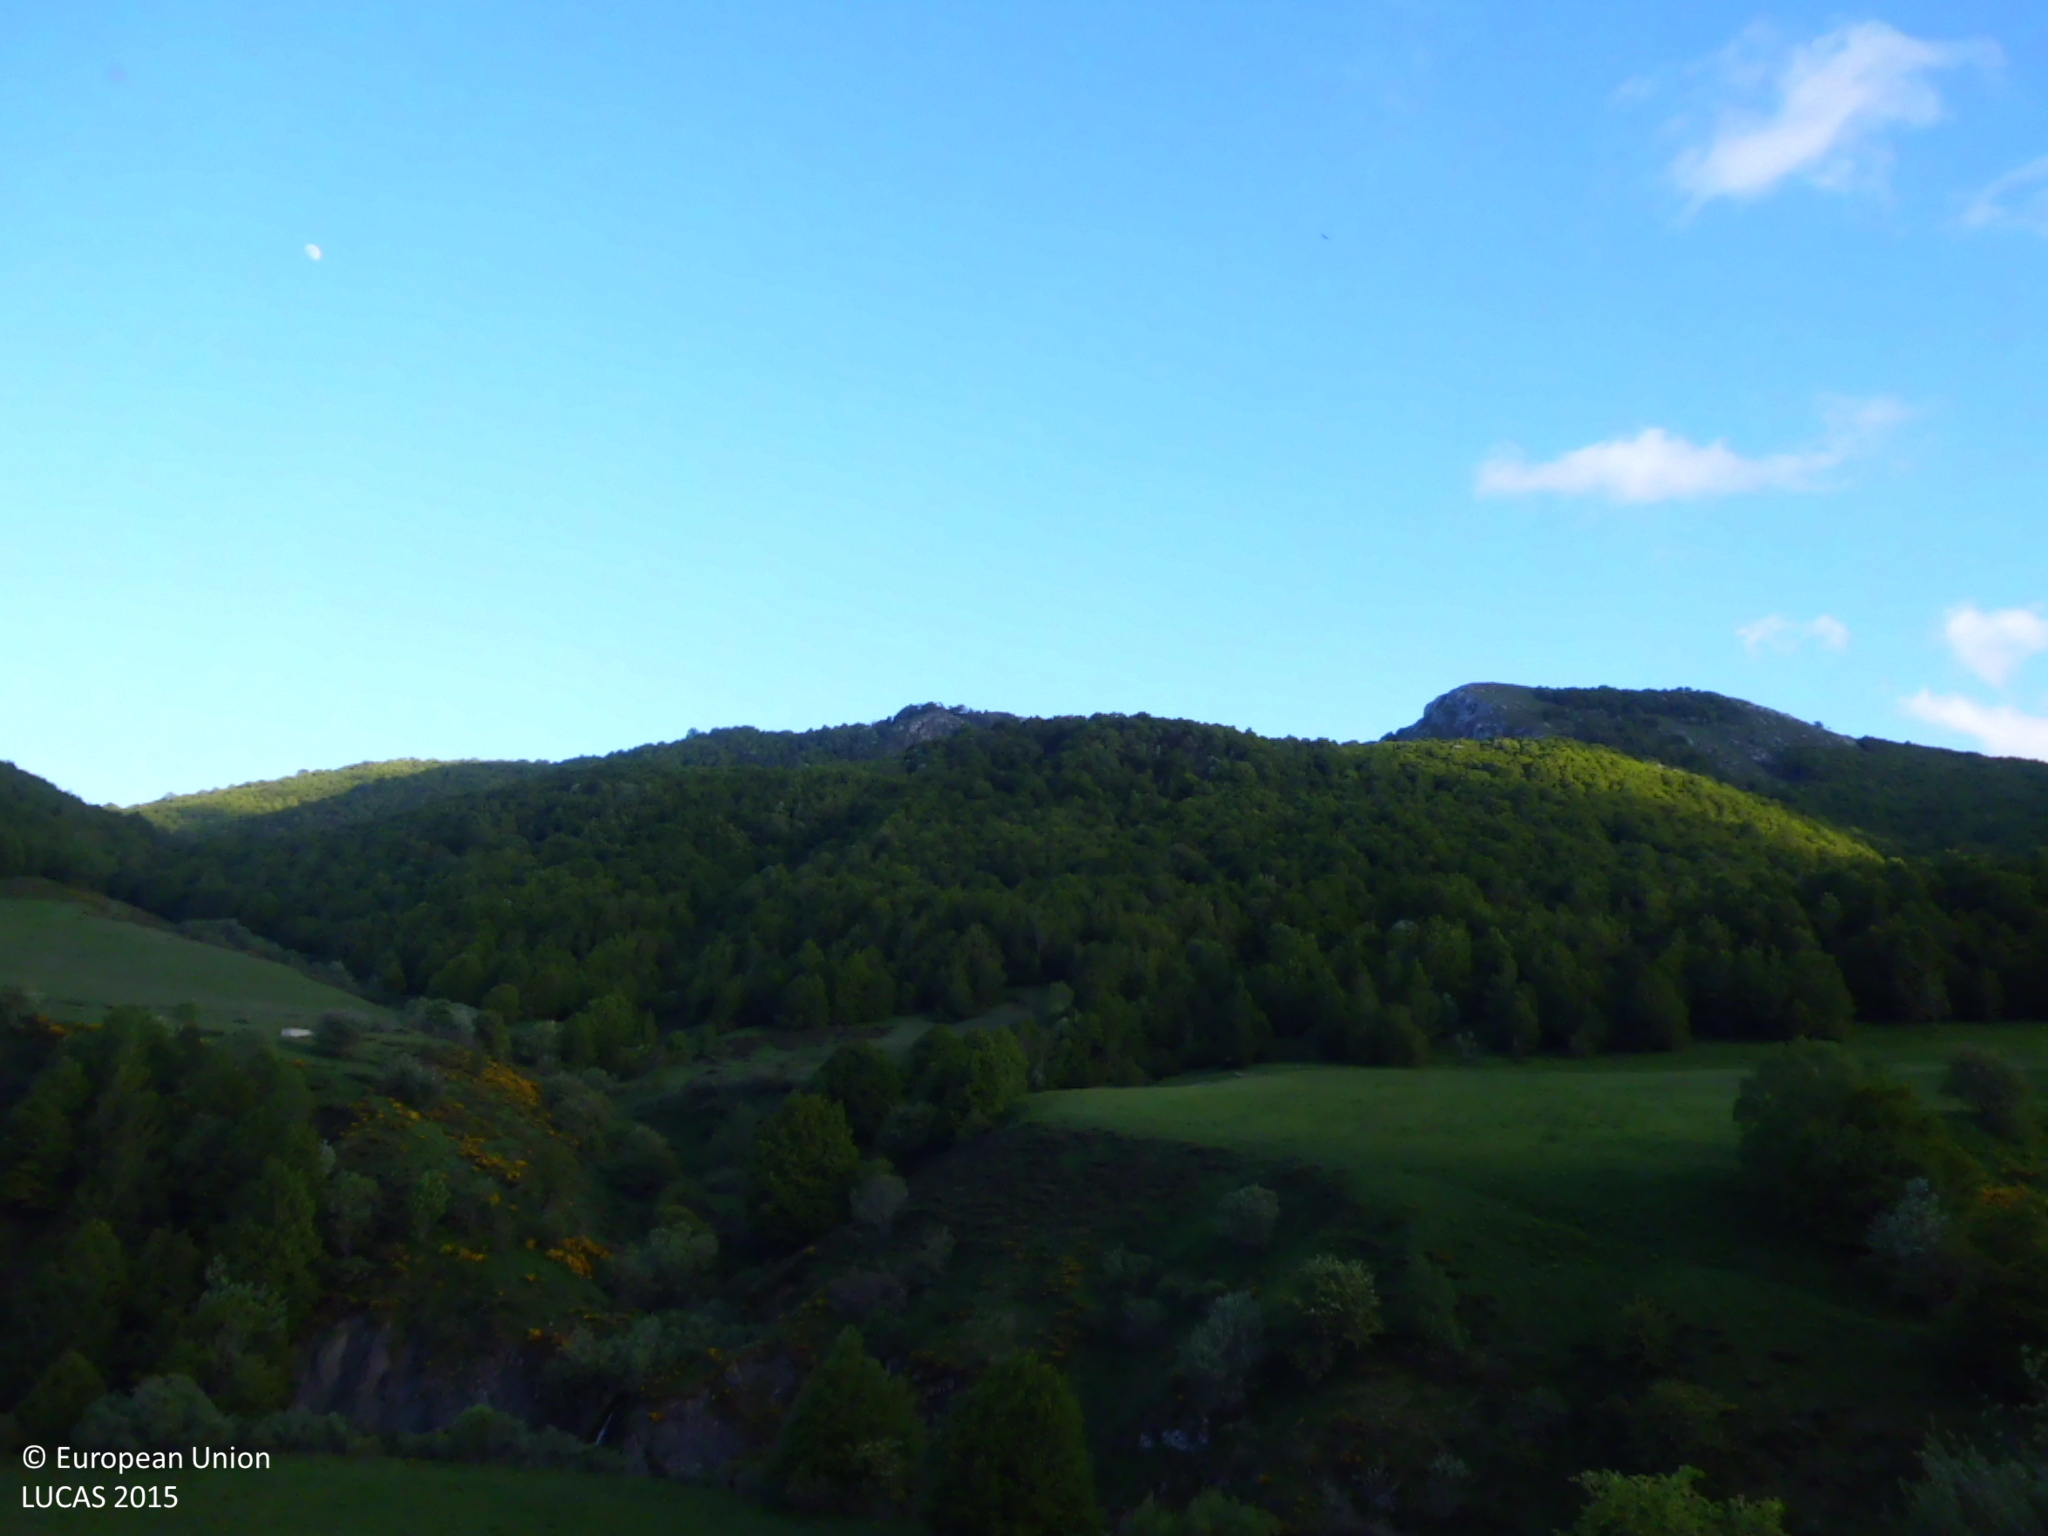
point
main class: Woodland
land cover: Broadleaved woodland
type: acidophilous oak and oak-birch forest
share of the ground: > 75 %
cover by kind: broadleaved forest trees 100 %
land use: Semi-natural and natural areas not in use
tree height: > 5 m
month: May
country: ES
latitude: 43.0639
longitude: -5.1612
